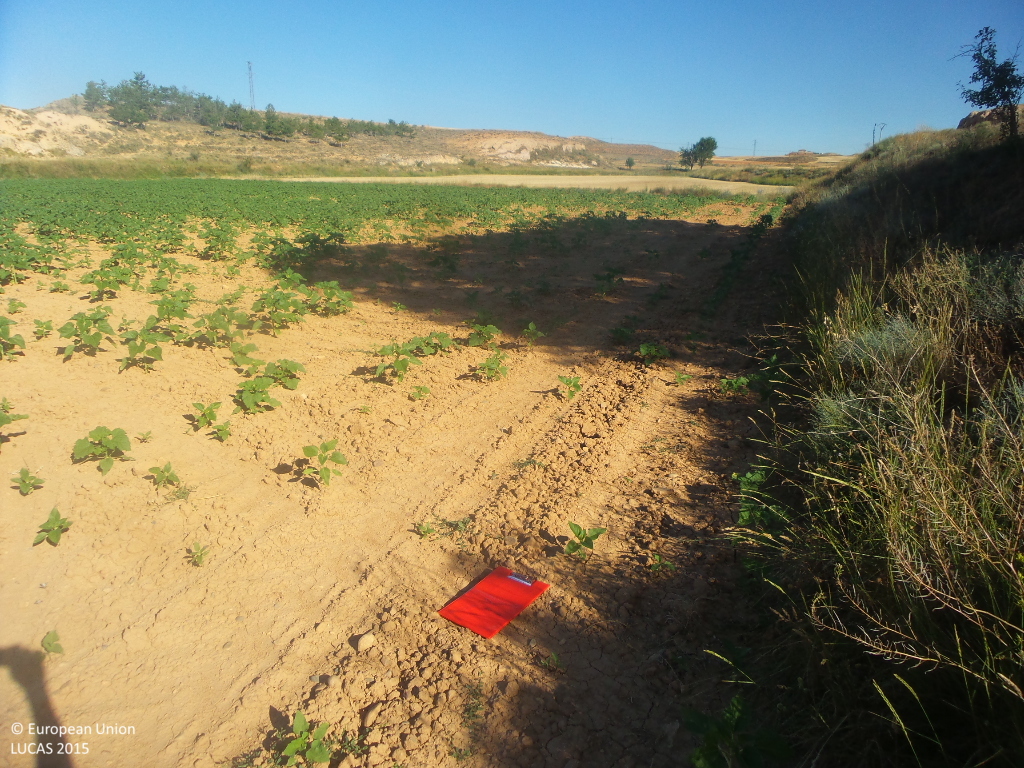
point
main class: Cropland
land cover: Sunflower
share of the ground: < 10 %
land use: Agriculture (excluding fallow land and kitchen gardens)
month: July
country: ES
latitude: 41.3703
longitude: -2.1655
